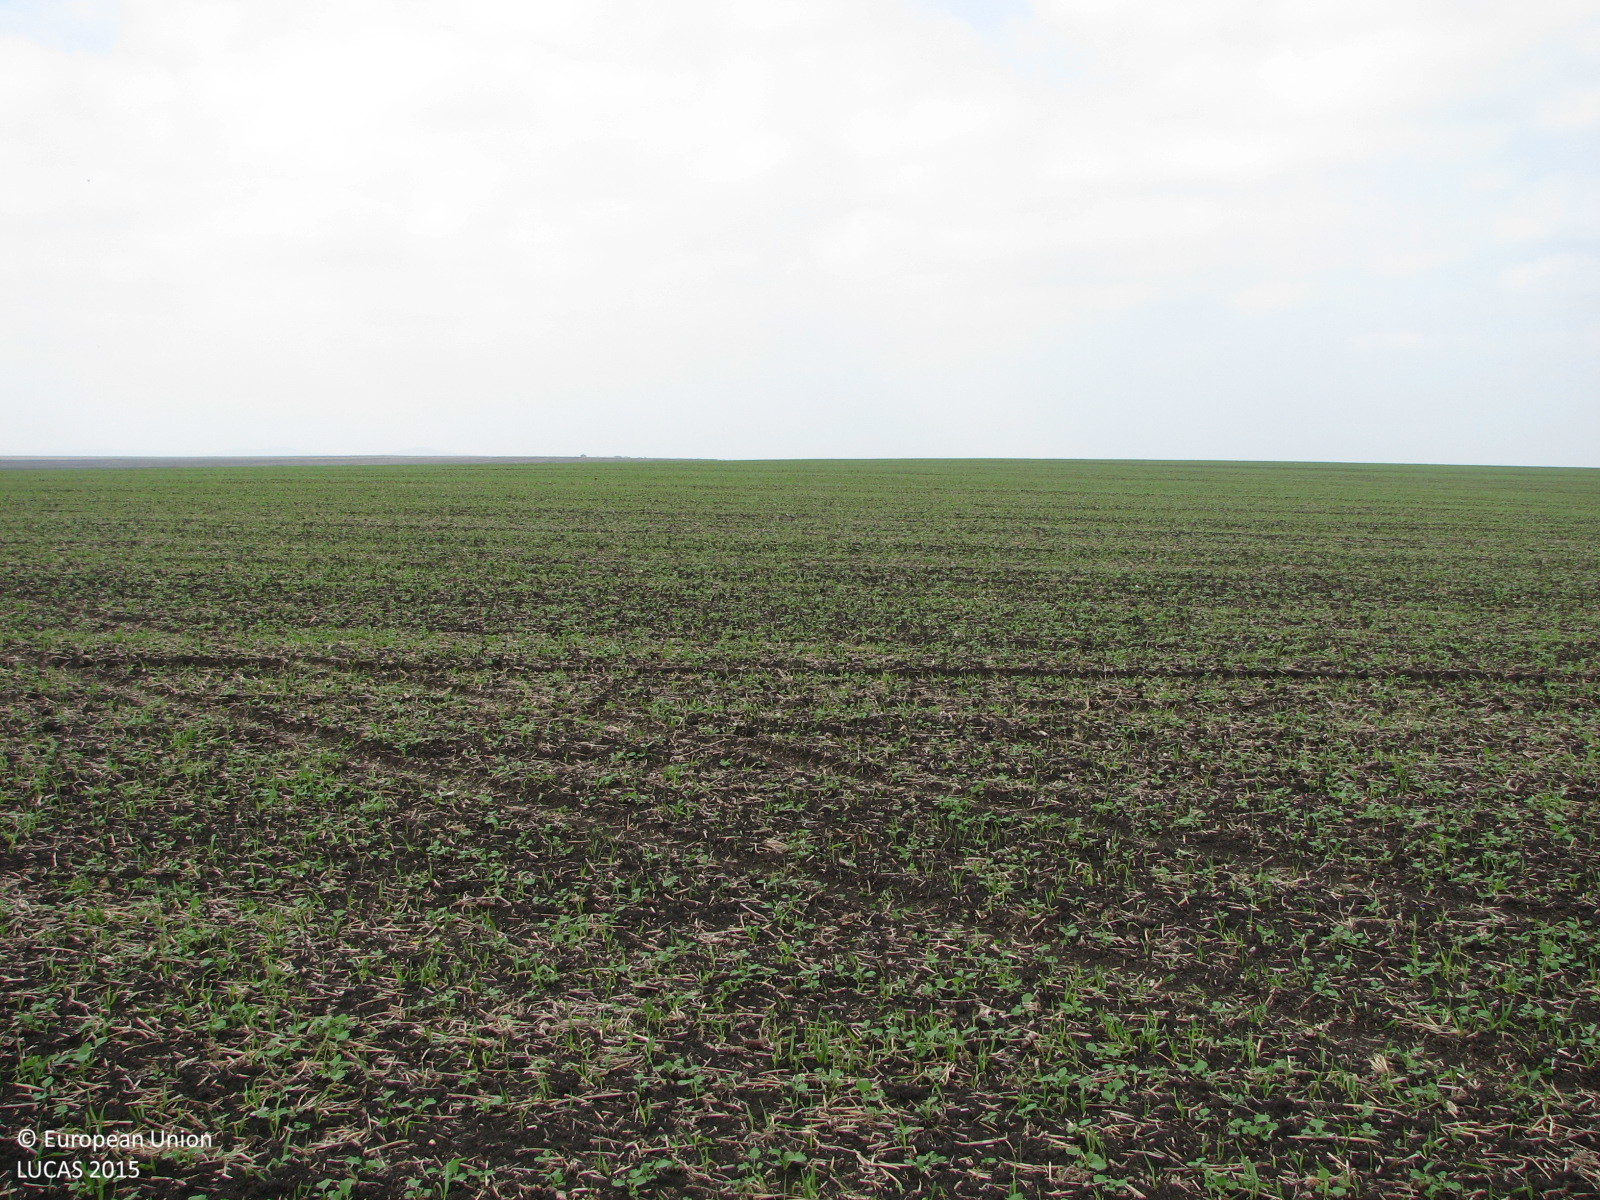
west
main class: Cropland
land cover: Rape and turnip rape
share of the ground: 10 - 25 %
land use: Agriculture (excluding fallow land and kitchen gardens)
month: October
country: BG
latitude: 42.3012
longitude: 26.5019
